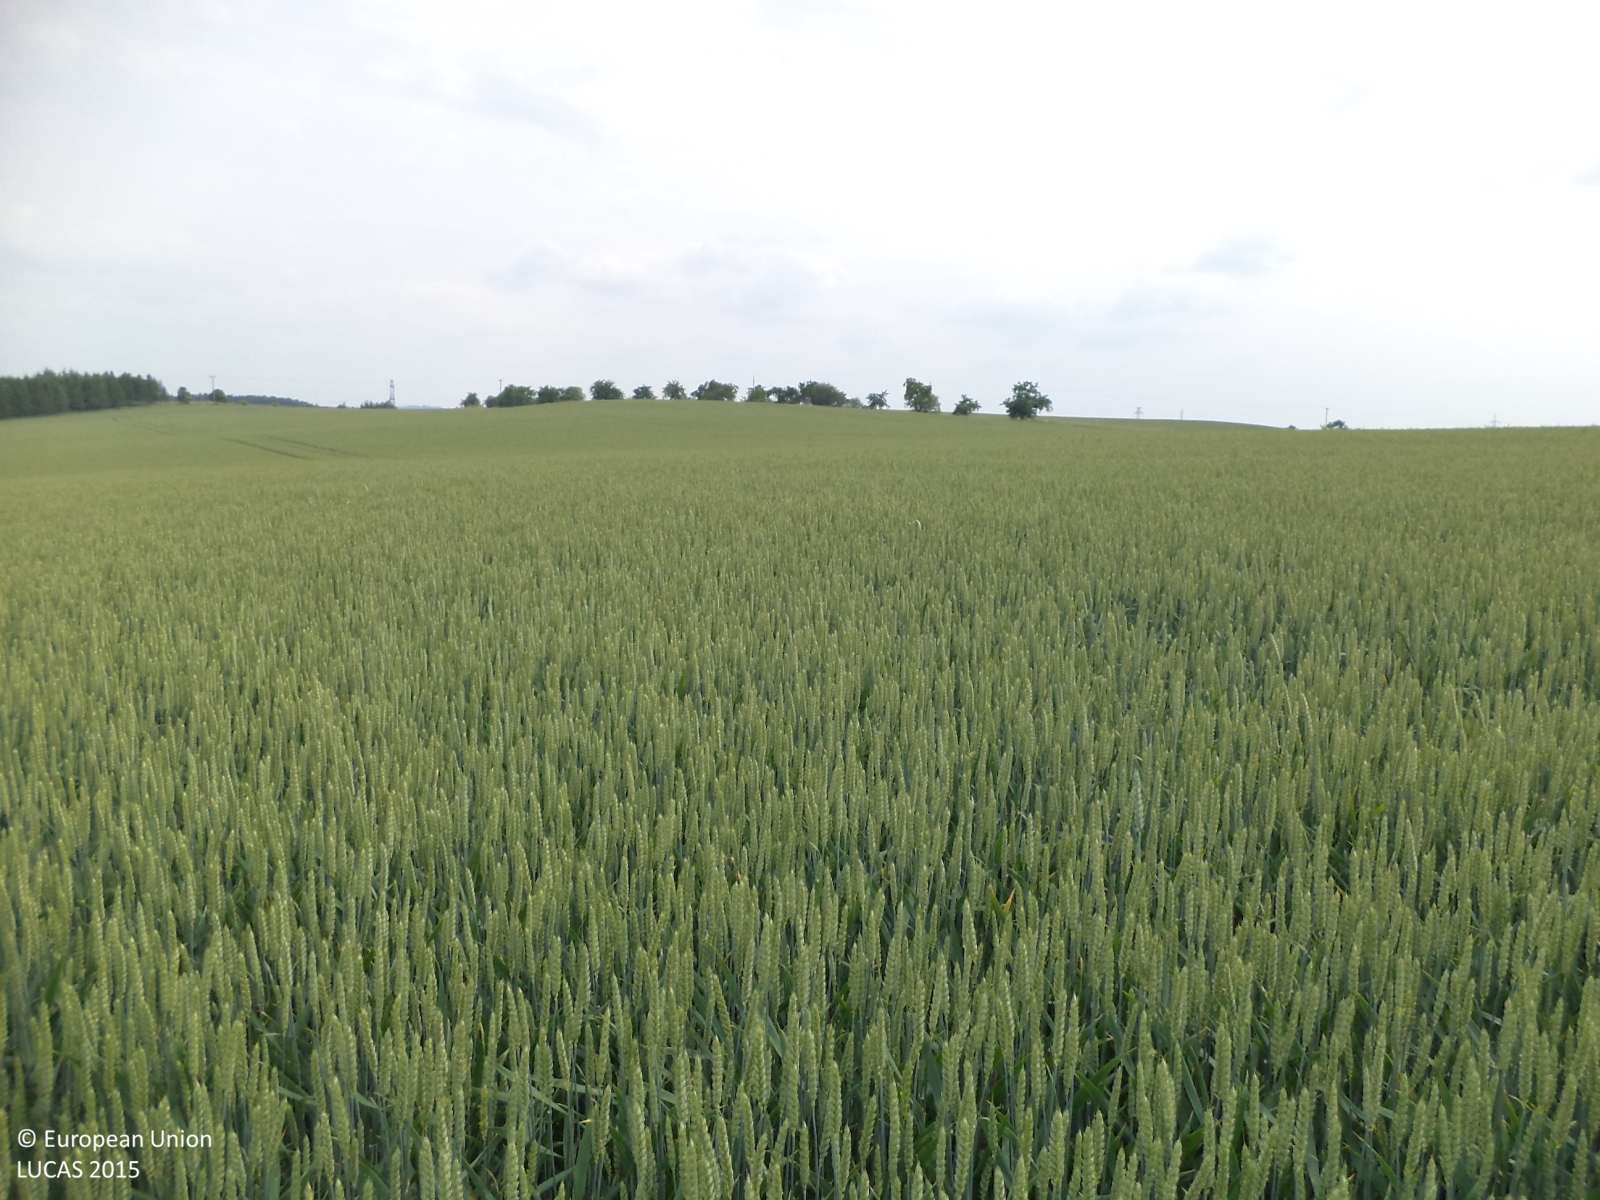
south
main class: Cropland
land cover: Common wheat
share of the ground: > 75 %
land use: Agriculture (excluding fallow land and kitchen gardens)
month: June
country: CZ
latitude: 49.1806
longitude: 14.4048
